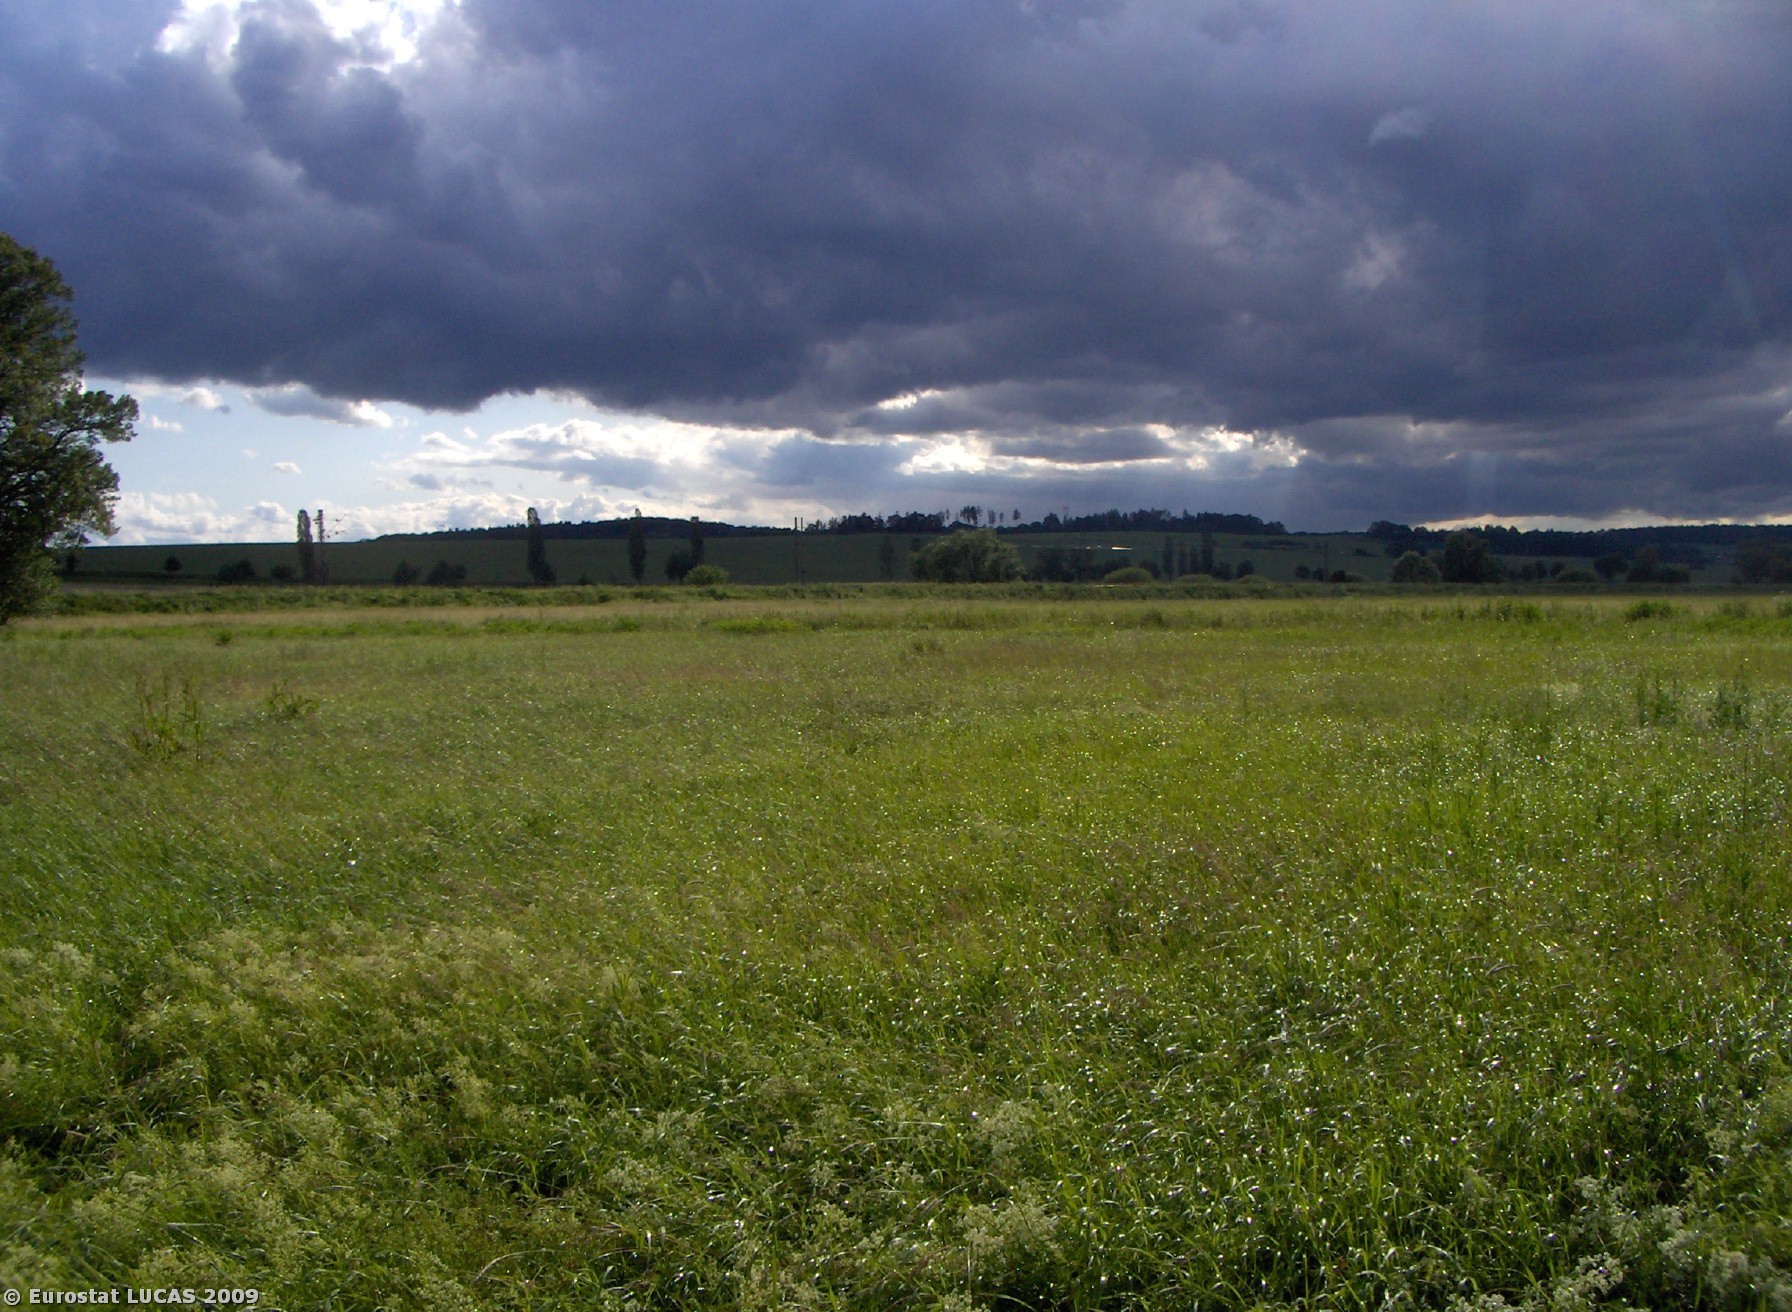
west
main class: Grassland
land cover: Grassland without tree/shrub cover
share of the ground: > 75 %
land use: Agriculture (excluding fallow land and kitchen gardens)
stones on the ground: < 10 %
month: June
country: CZ
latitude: 49.2259
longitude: 14.1613
